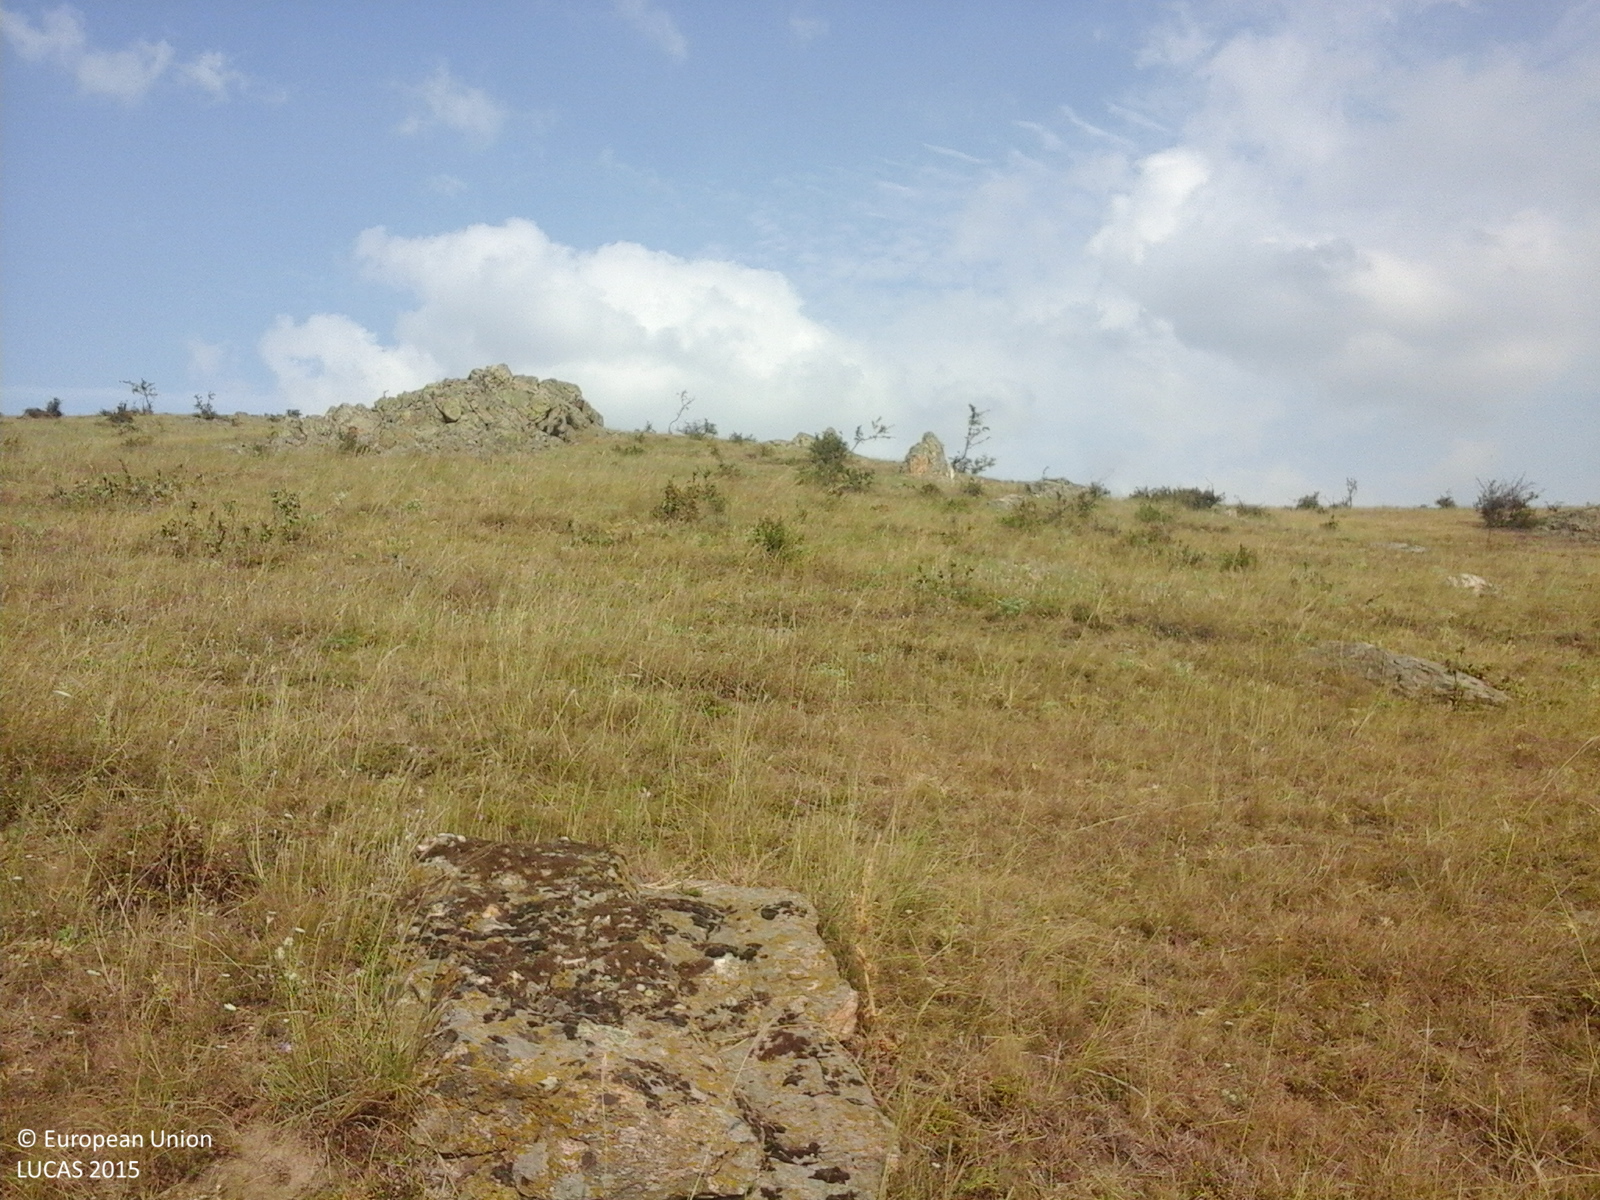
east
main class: Grassland
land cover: Grassland without tree/shrub cover
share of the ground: > 75 %
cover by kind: herbaceous plants 100 %
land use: Agriculture (excluding fallow land and kitchen gardens)
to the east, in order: Grassland without tree/shrub cover; Grassland with sparse tree/shrub cover
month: July
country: RO
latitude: 45.0772
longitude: 28.4586
